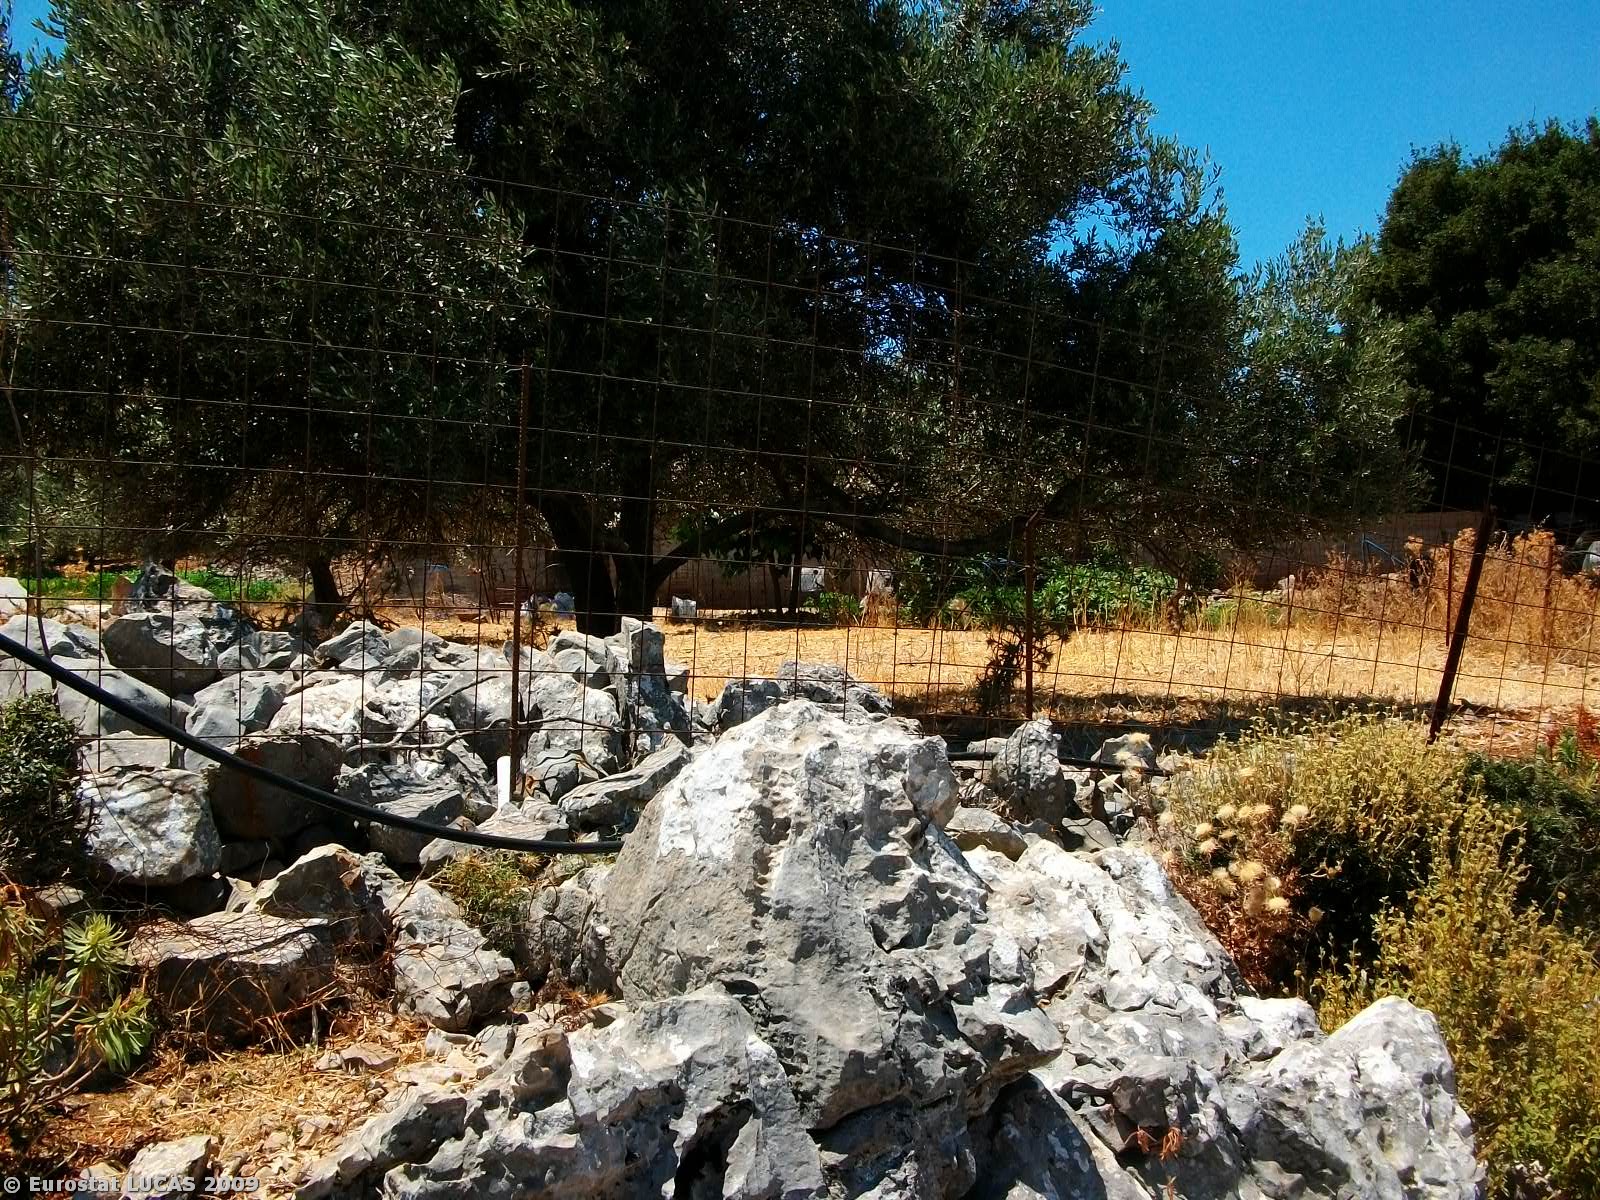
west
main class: Shrubland
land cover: Shrubland without tree cover
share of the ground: 50 - 75 %
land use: Unused
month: July
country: GR
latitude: 35.3257
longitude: 24.9408
